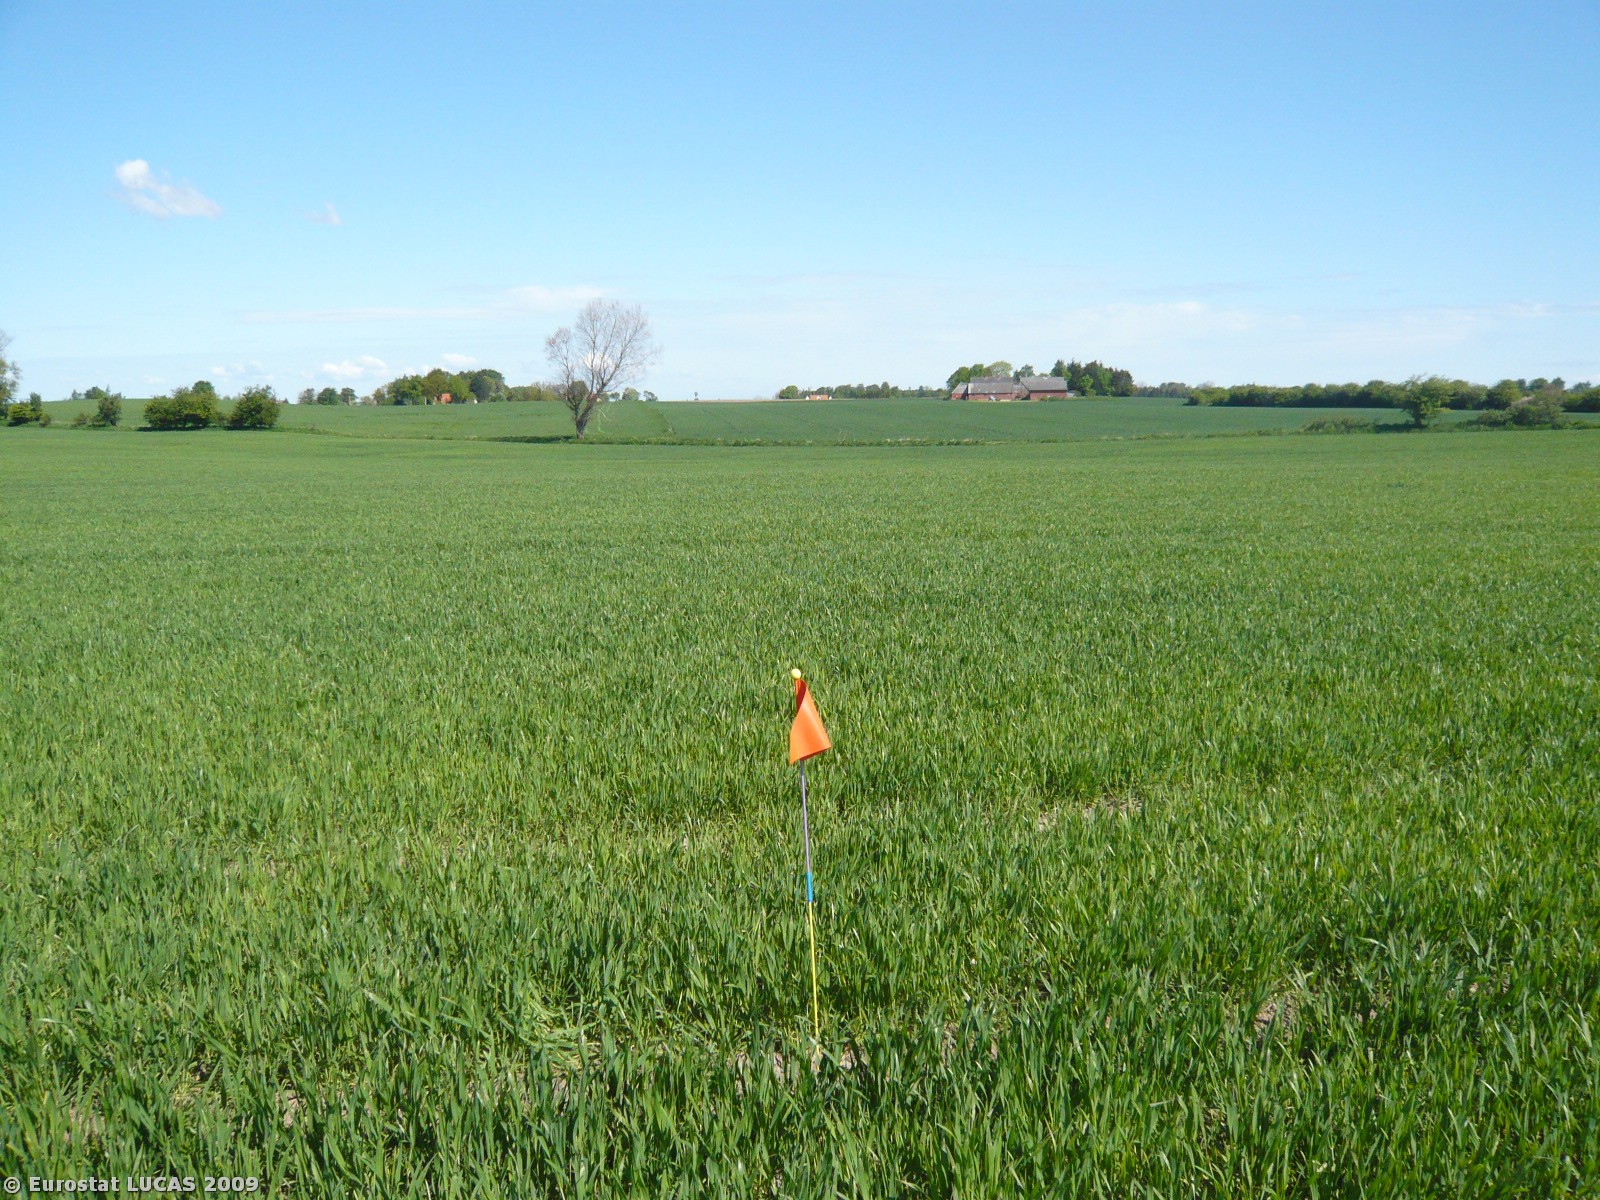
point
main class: Cropland
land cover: Common wheat
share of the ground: > 75 %
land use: Agriculture (excluding fallow land and kitchen gardens)
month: May
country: DK
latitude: 55.0746
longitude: 12.0503
